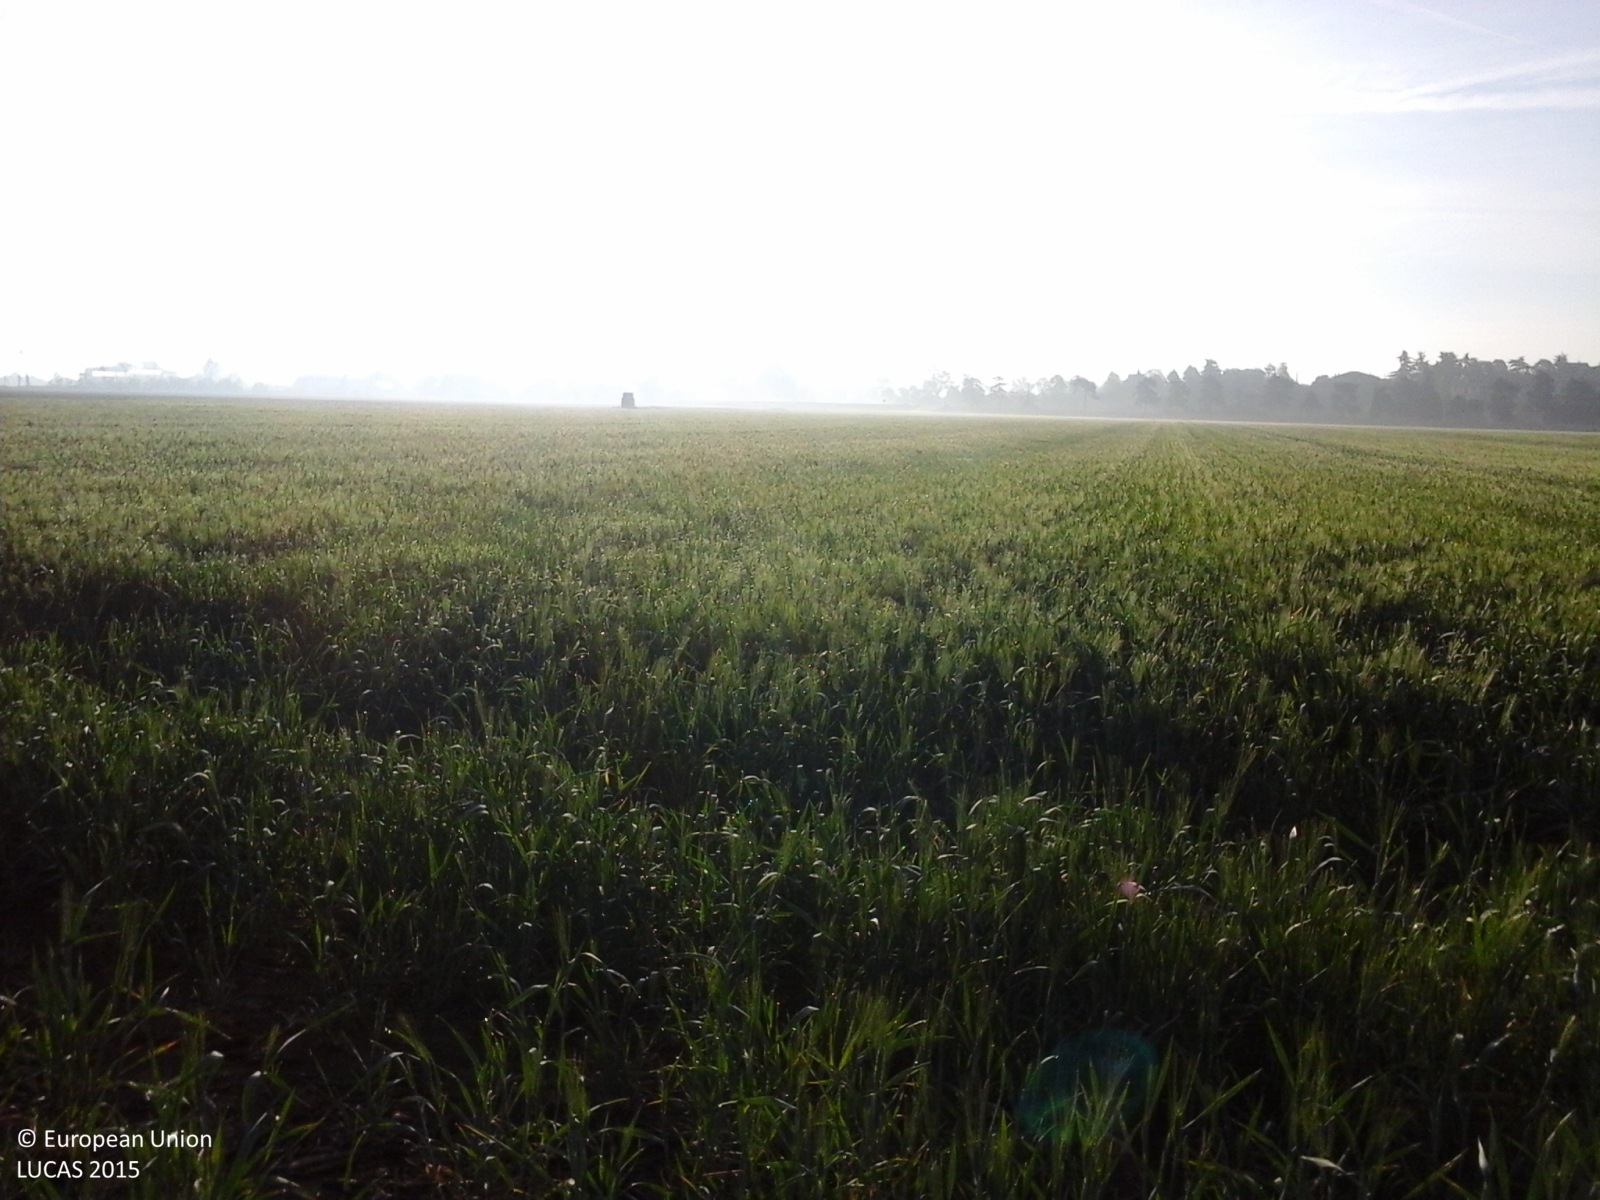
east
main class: Cropland
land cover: Common wheat
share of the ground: > 75 %
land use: Agriculture (excluding fallow land and kitchen gardens)
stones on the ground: < 10 %
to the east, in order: Common wheat
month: May
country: IT
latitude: 44.9269
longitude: 9.6080
